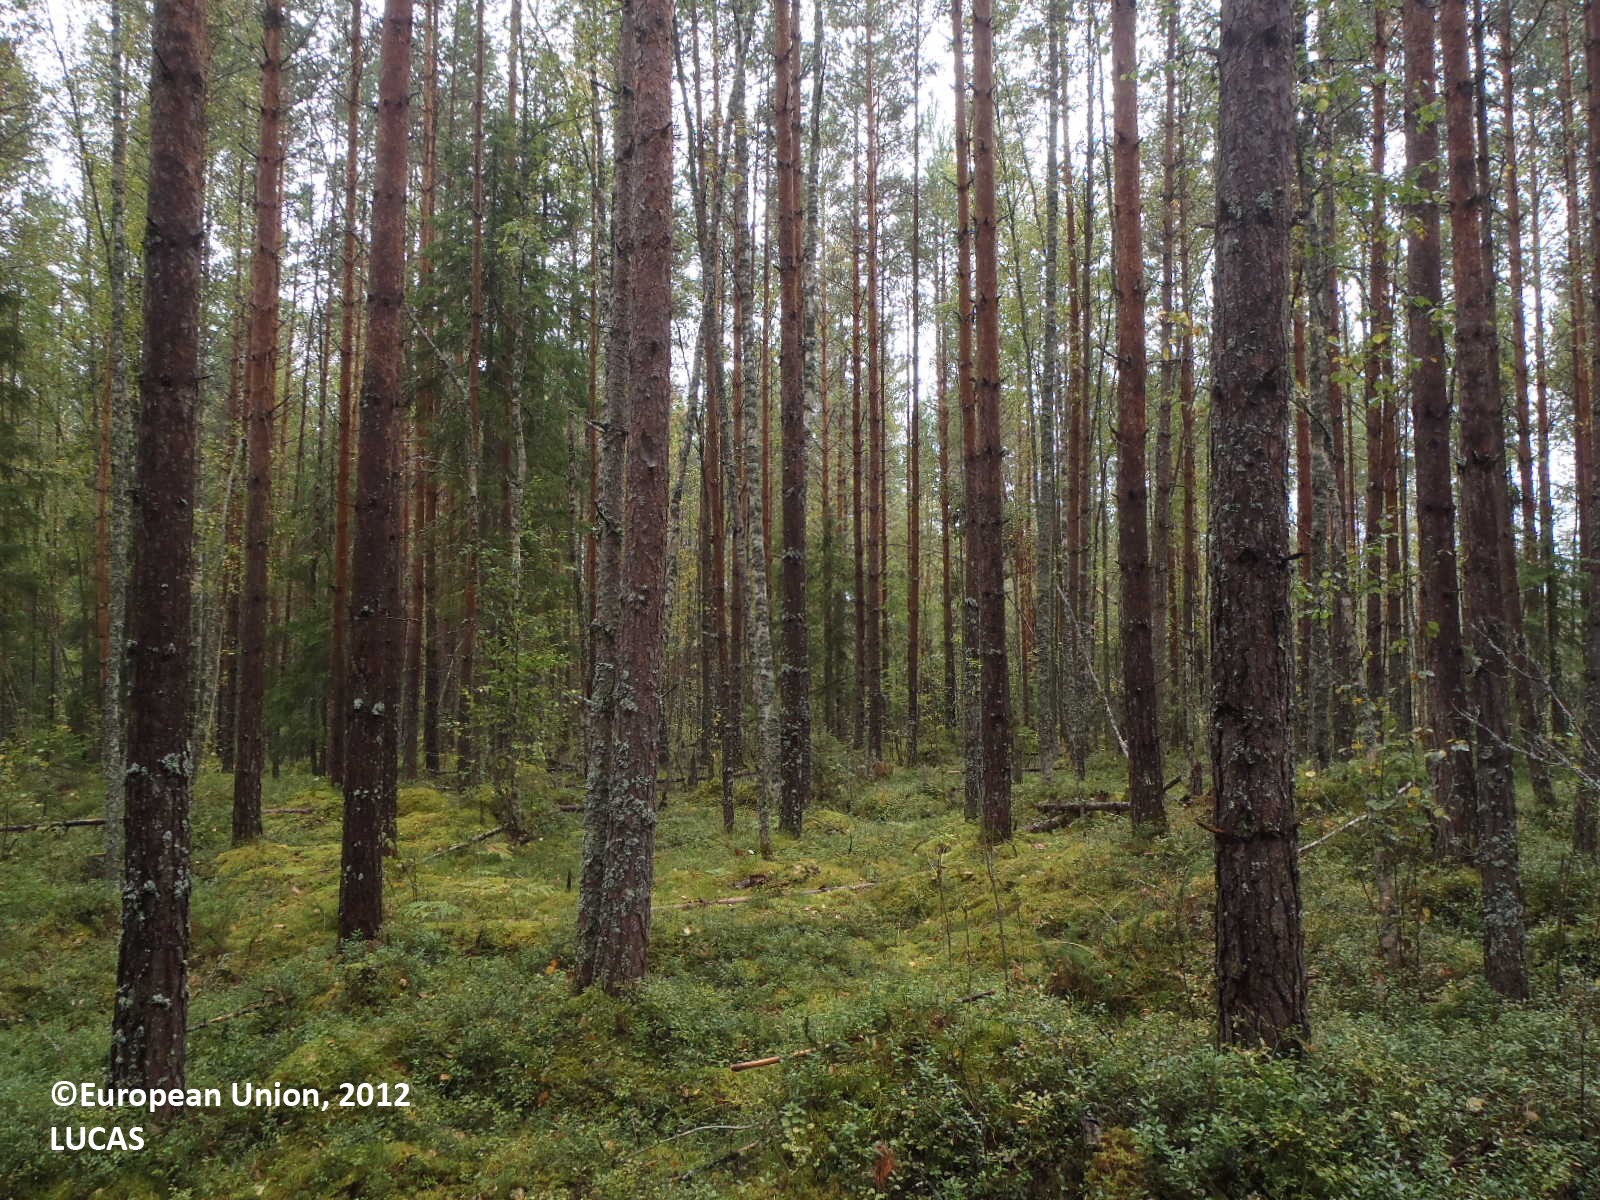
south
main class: Woodland
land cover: Spruce dominated coniferous woodland
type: boreal forest
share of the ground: > 75 %
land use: Forestry
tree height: > 5 m
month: September
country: FI
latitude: 61.6032
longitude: 22.8285
